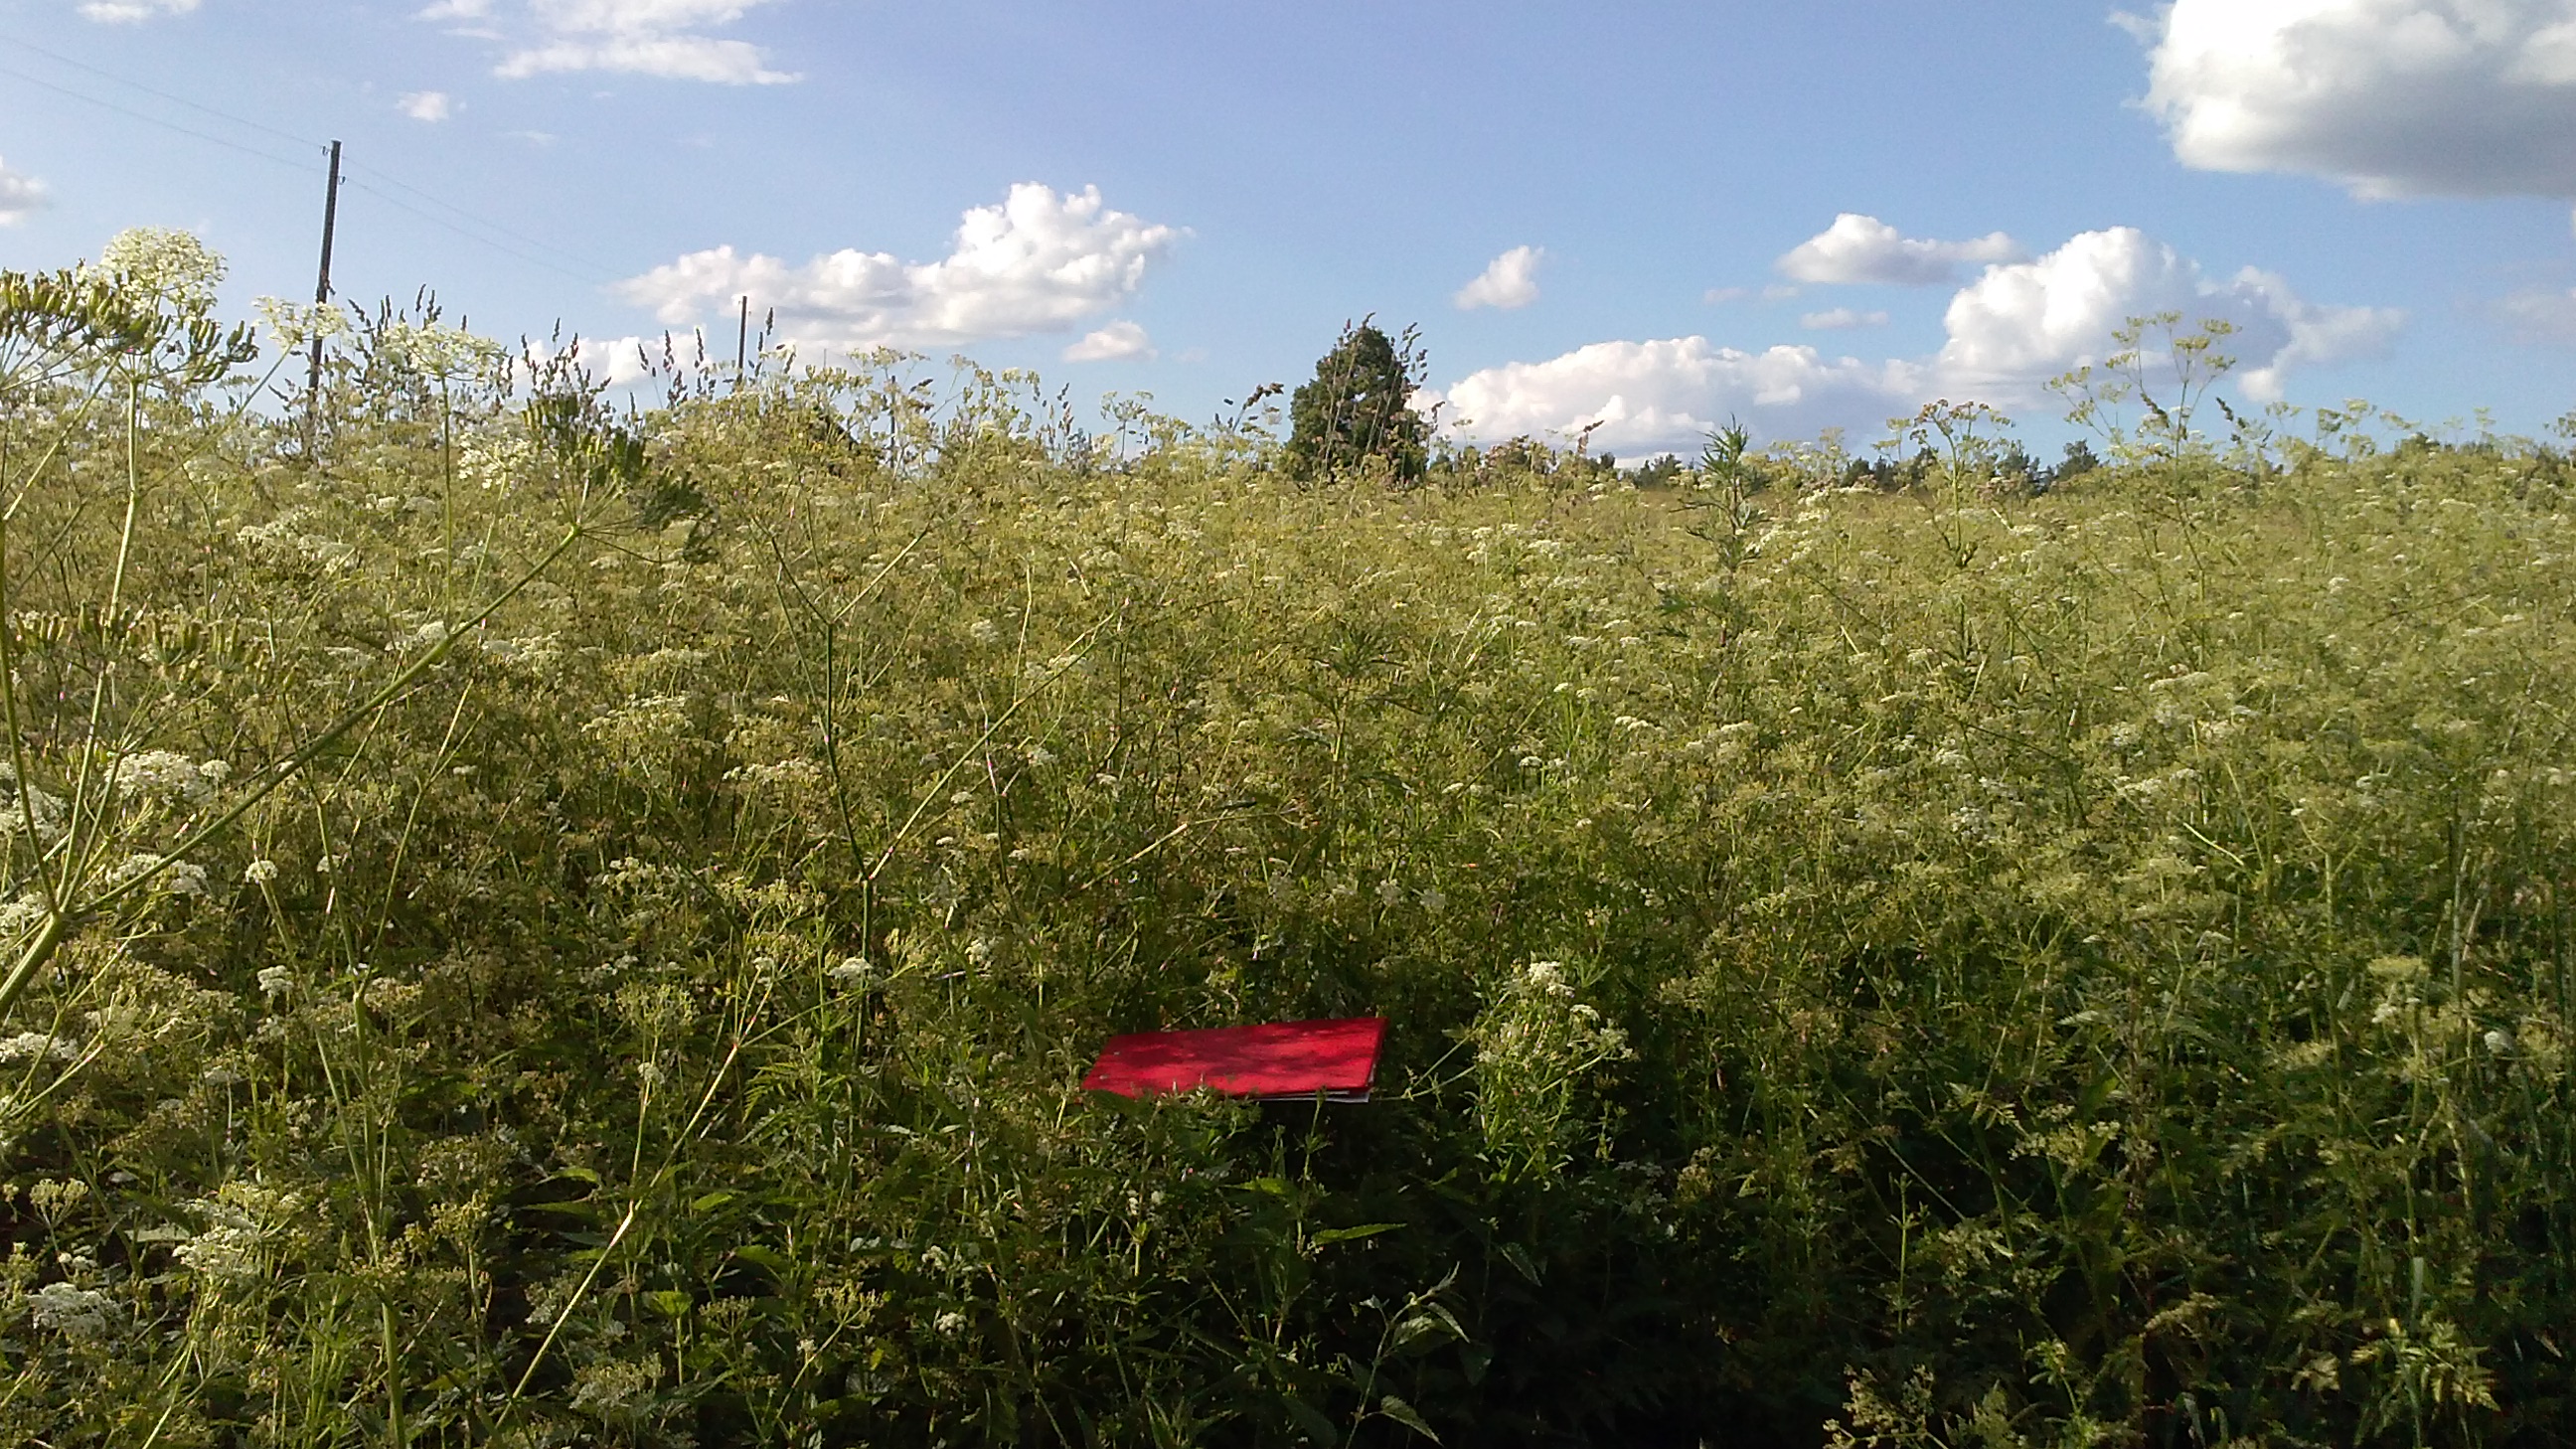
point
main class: Grassland
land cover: Spontaneously vegetated surfaces
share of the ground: > 75 %
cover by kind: herbaceous plants 100 %
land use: Semi-natural and natural areas not in use
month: June
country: LV
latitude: 56.5300
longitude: 27.9653
